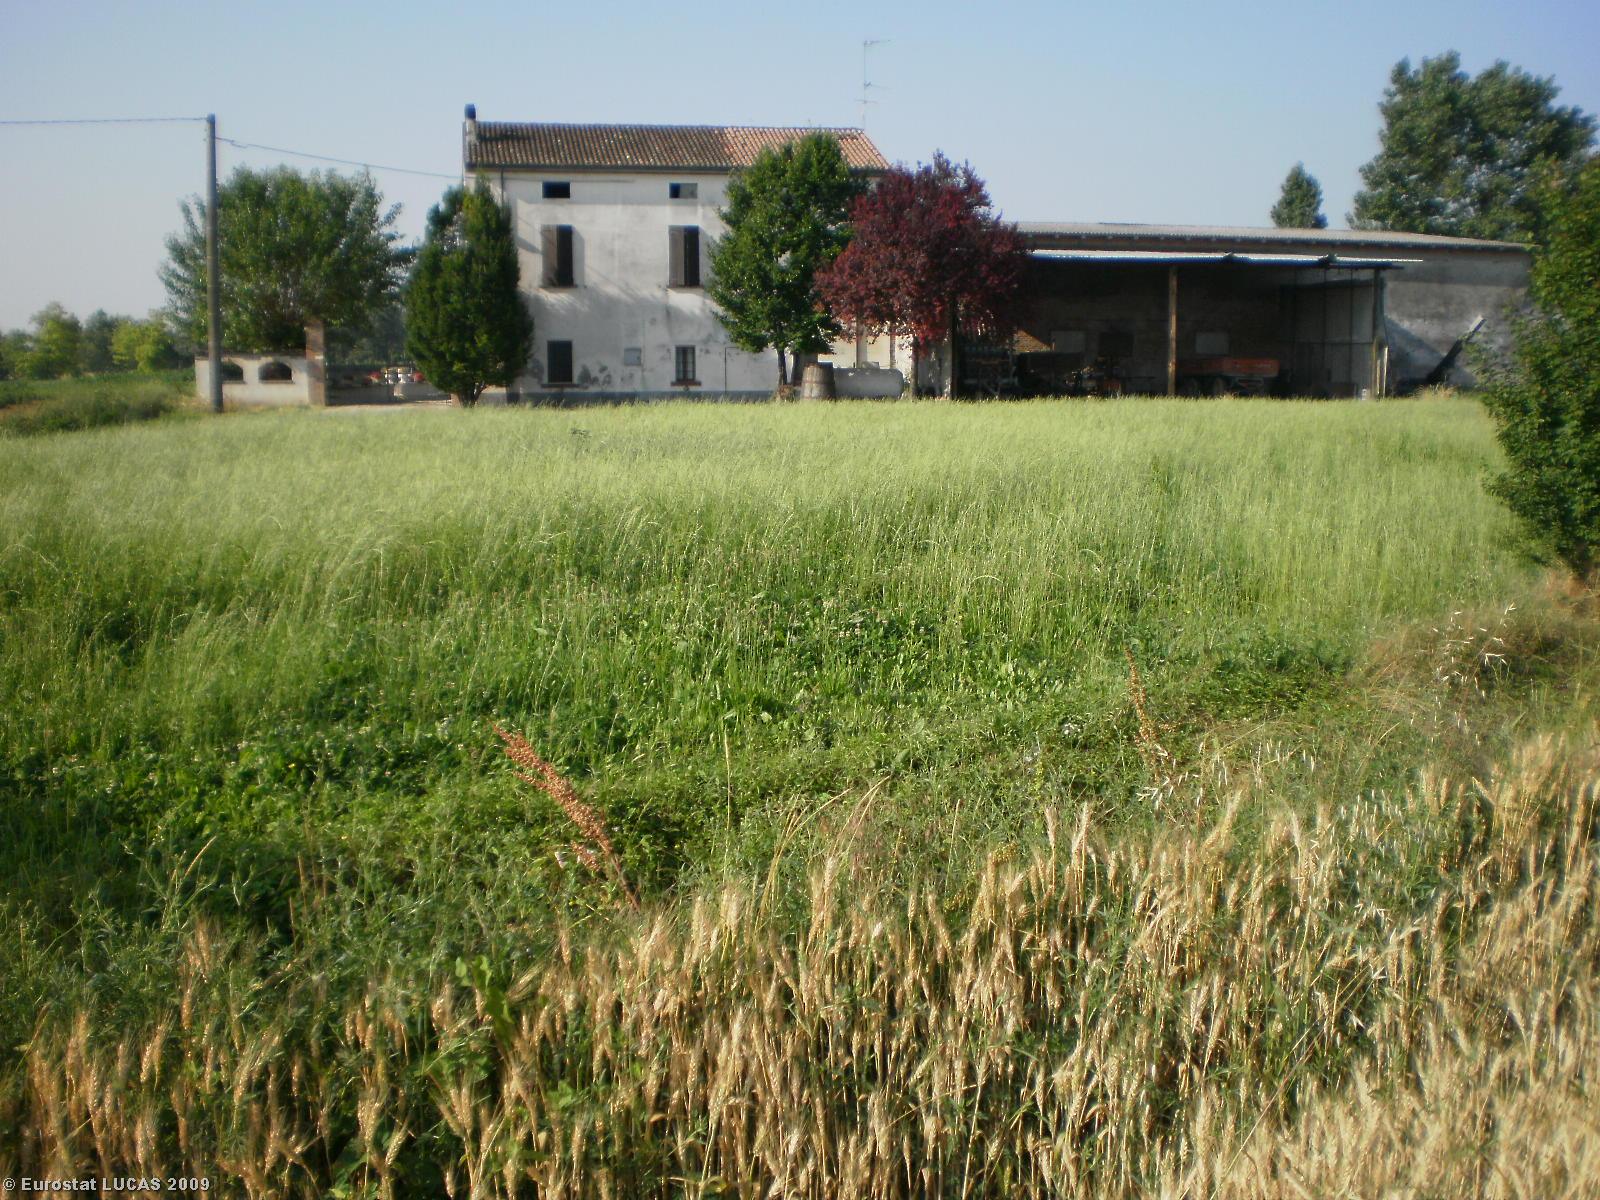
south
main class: Cropland
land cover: Common wheat
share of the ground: > 75 %
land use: Agriculture (excluding fallow land and kitchen gardens)
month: June
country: IT
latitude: 45.1790
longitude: 10.4446
